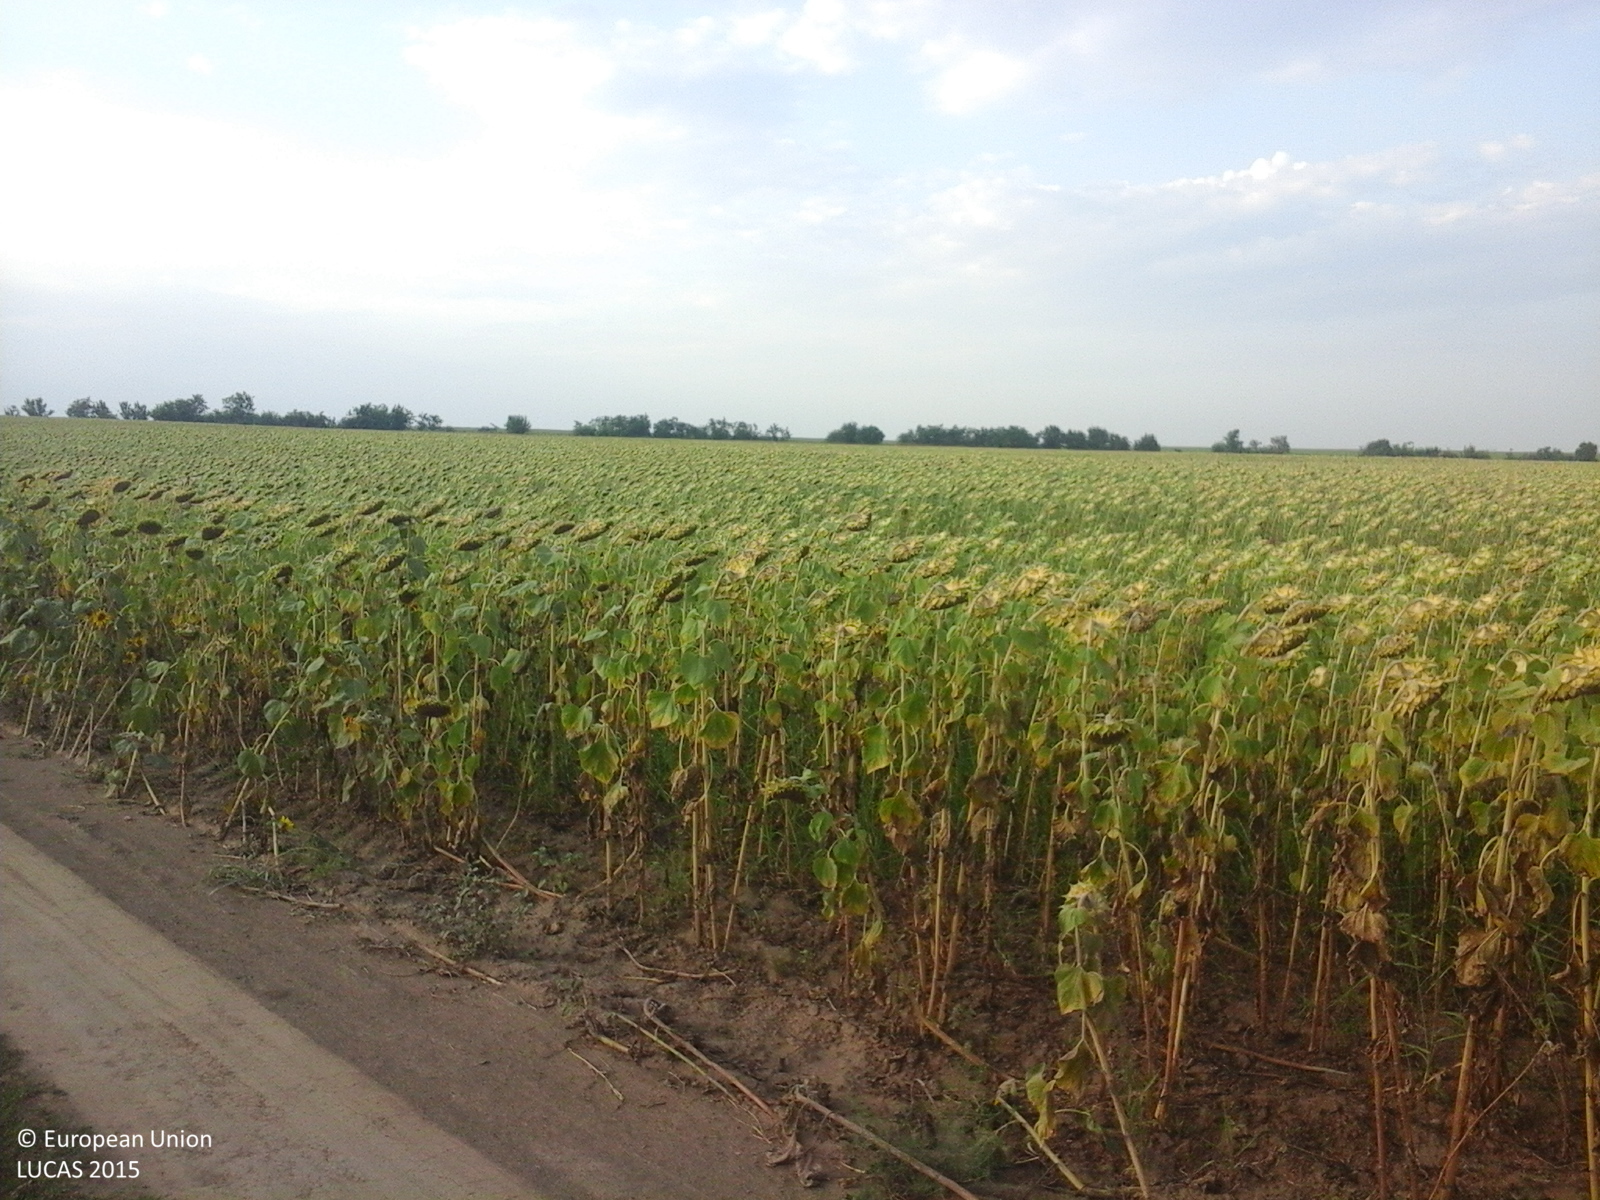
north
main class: Cropland
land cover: Sunflower
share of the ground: > 75 %
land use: Agriculture (excluding fallow land and kitchen gardens)
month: August
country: RO
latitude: 44.3981
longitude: 28.1270
